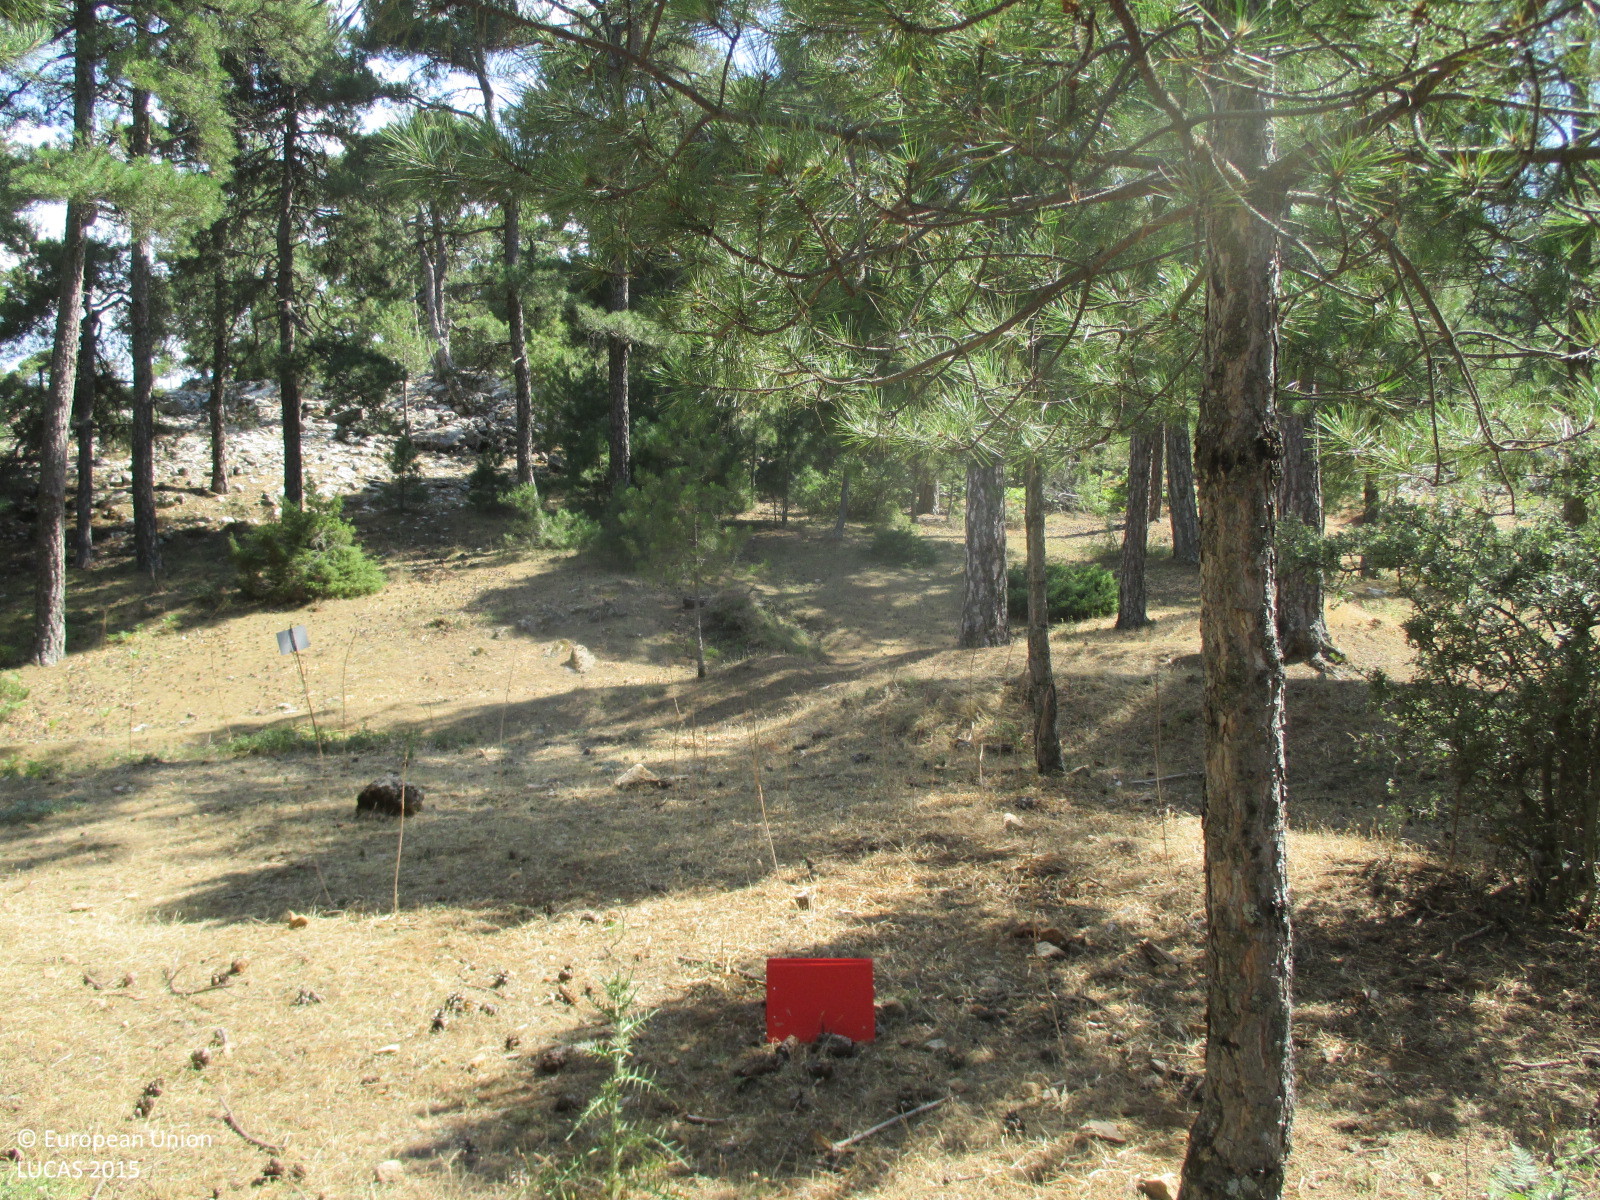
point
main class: Woodland
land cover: Pine dominated coniferous woodland
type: coniferous forest of the mediterranean region
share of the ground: > 75 %
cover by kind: coniferous forest trees 90 %, lichens and mosses 10 %
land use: Forestry
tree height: > 5 m
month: July
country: ES
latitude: 38.3419
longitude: -2.5485
